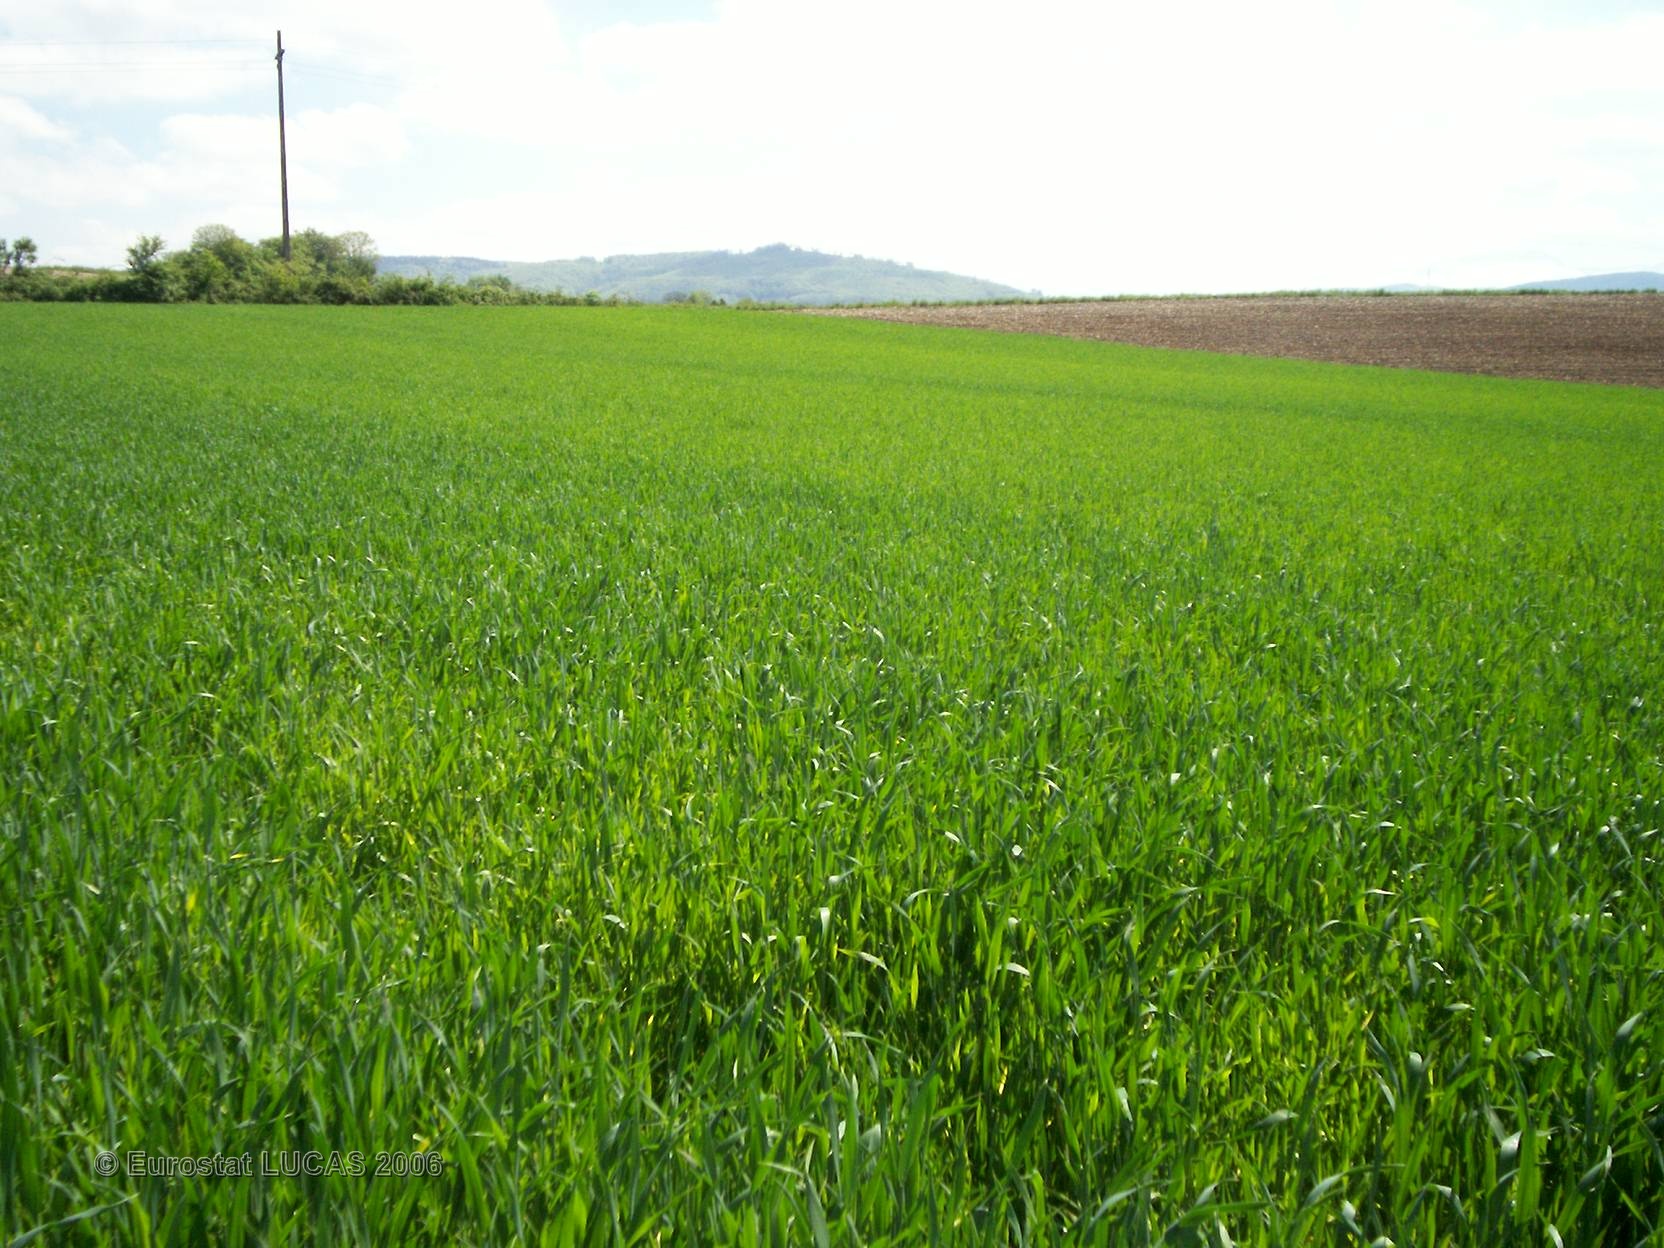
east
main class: Cropland
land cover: Common wheat
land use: Agriculture (excluding fallow land and kitchen gardens)
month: May
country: FR
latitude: 45.4409
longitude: 5.4152
